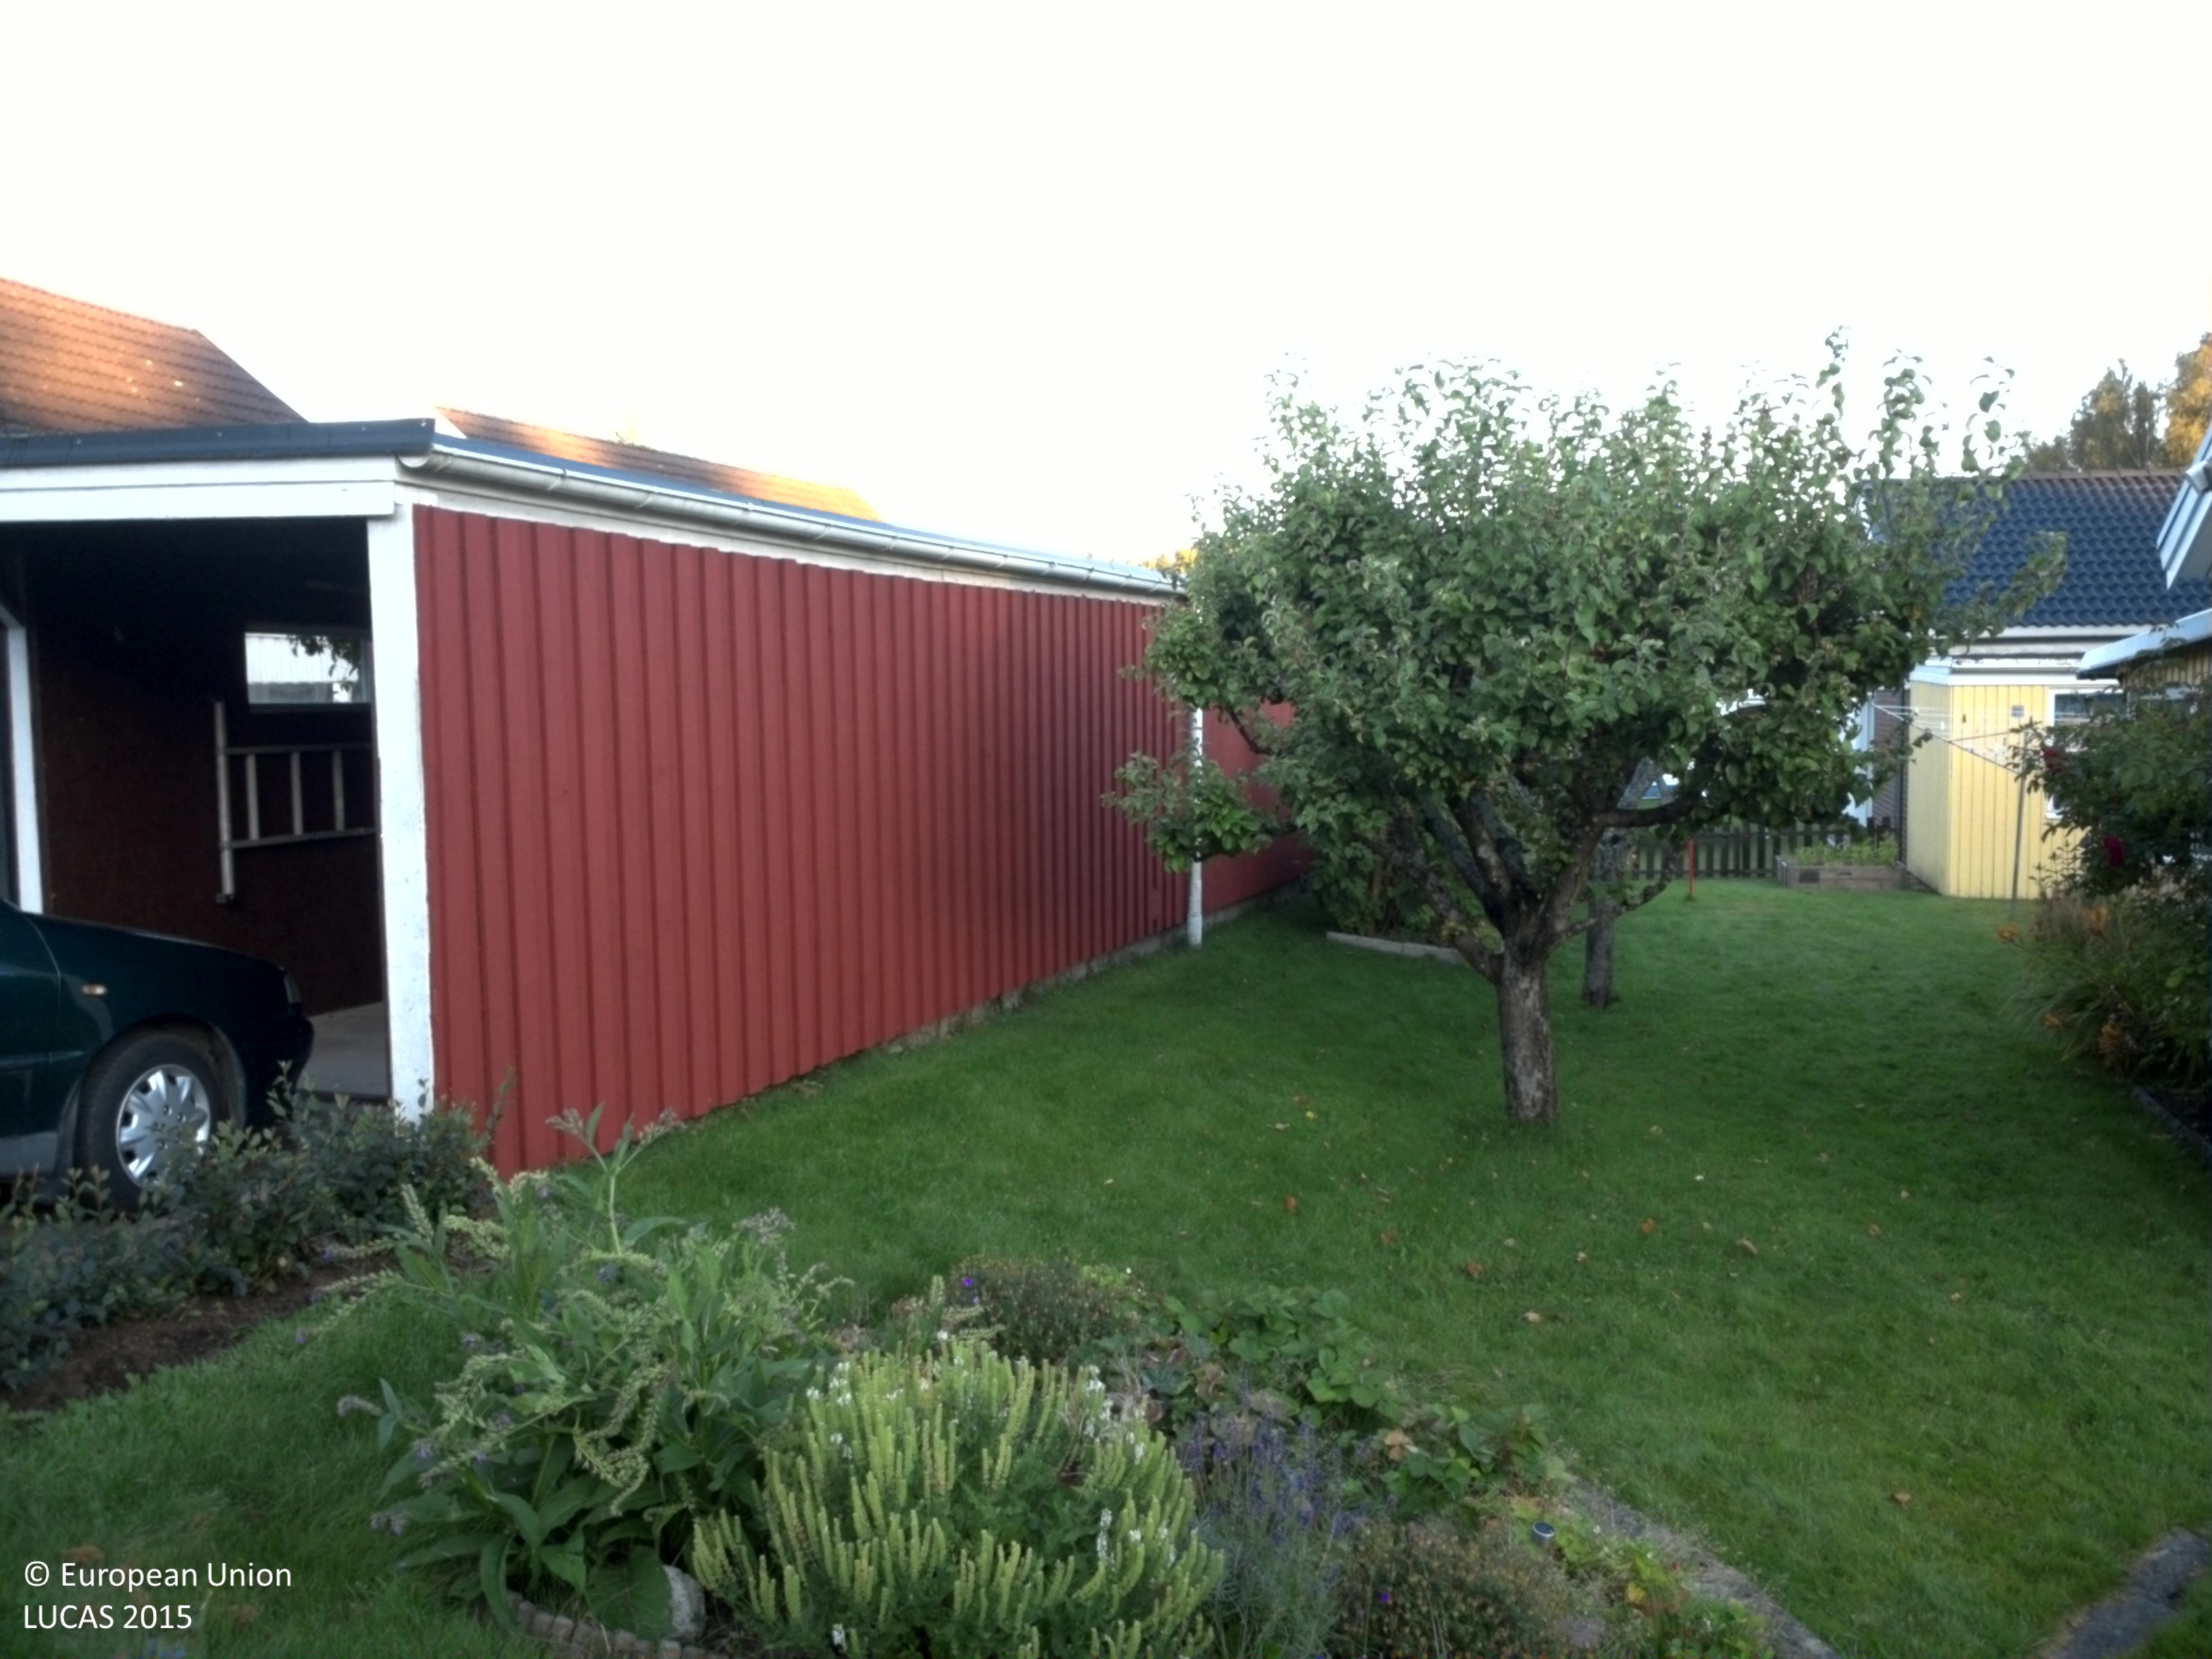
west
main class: Grassland
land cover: Grassland with sparse tree/shrub cover
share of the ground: > 75 %
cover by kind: herbaceous plants 90 %, broadleaved forest trees 5 %, consolidated bare surface 5 %
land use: Residential
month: August
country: SE
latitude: 59.5433
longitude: 13.4762
